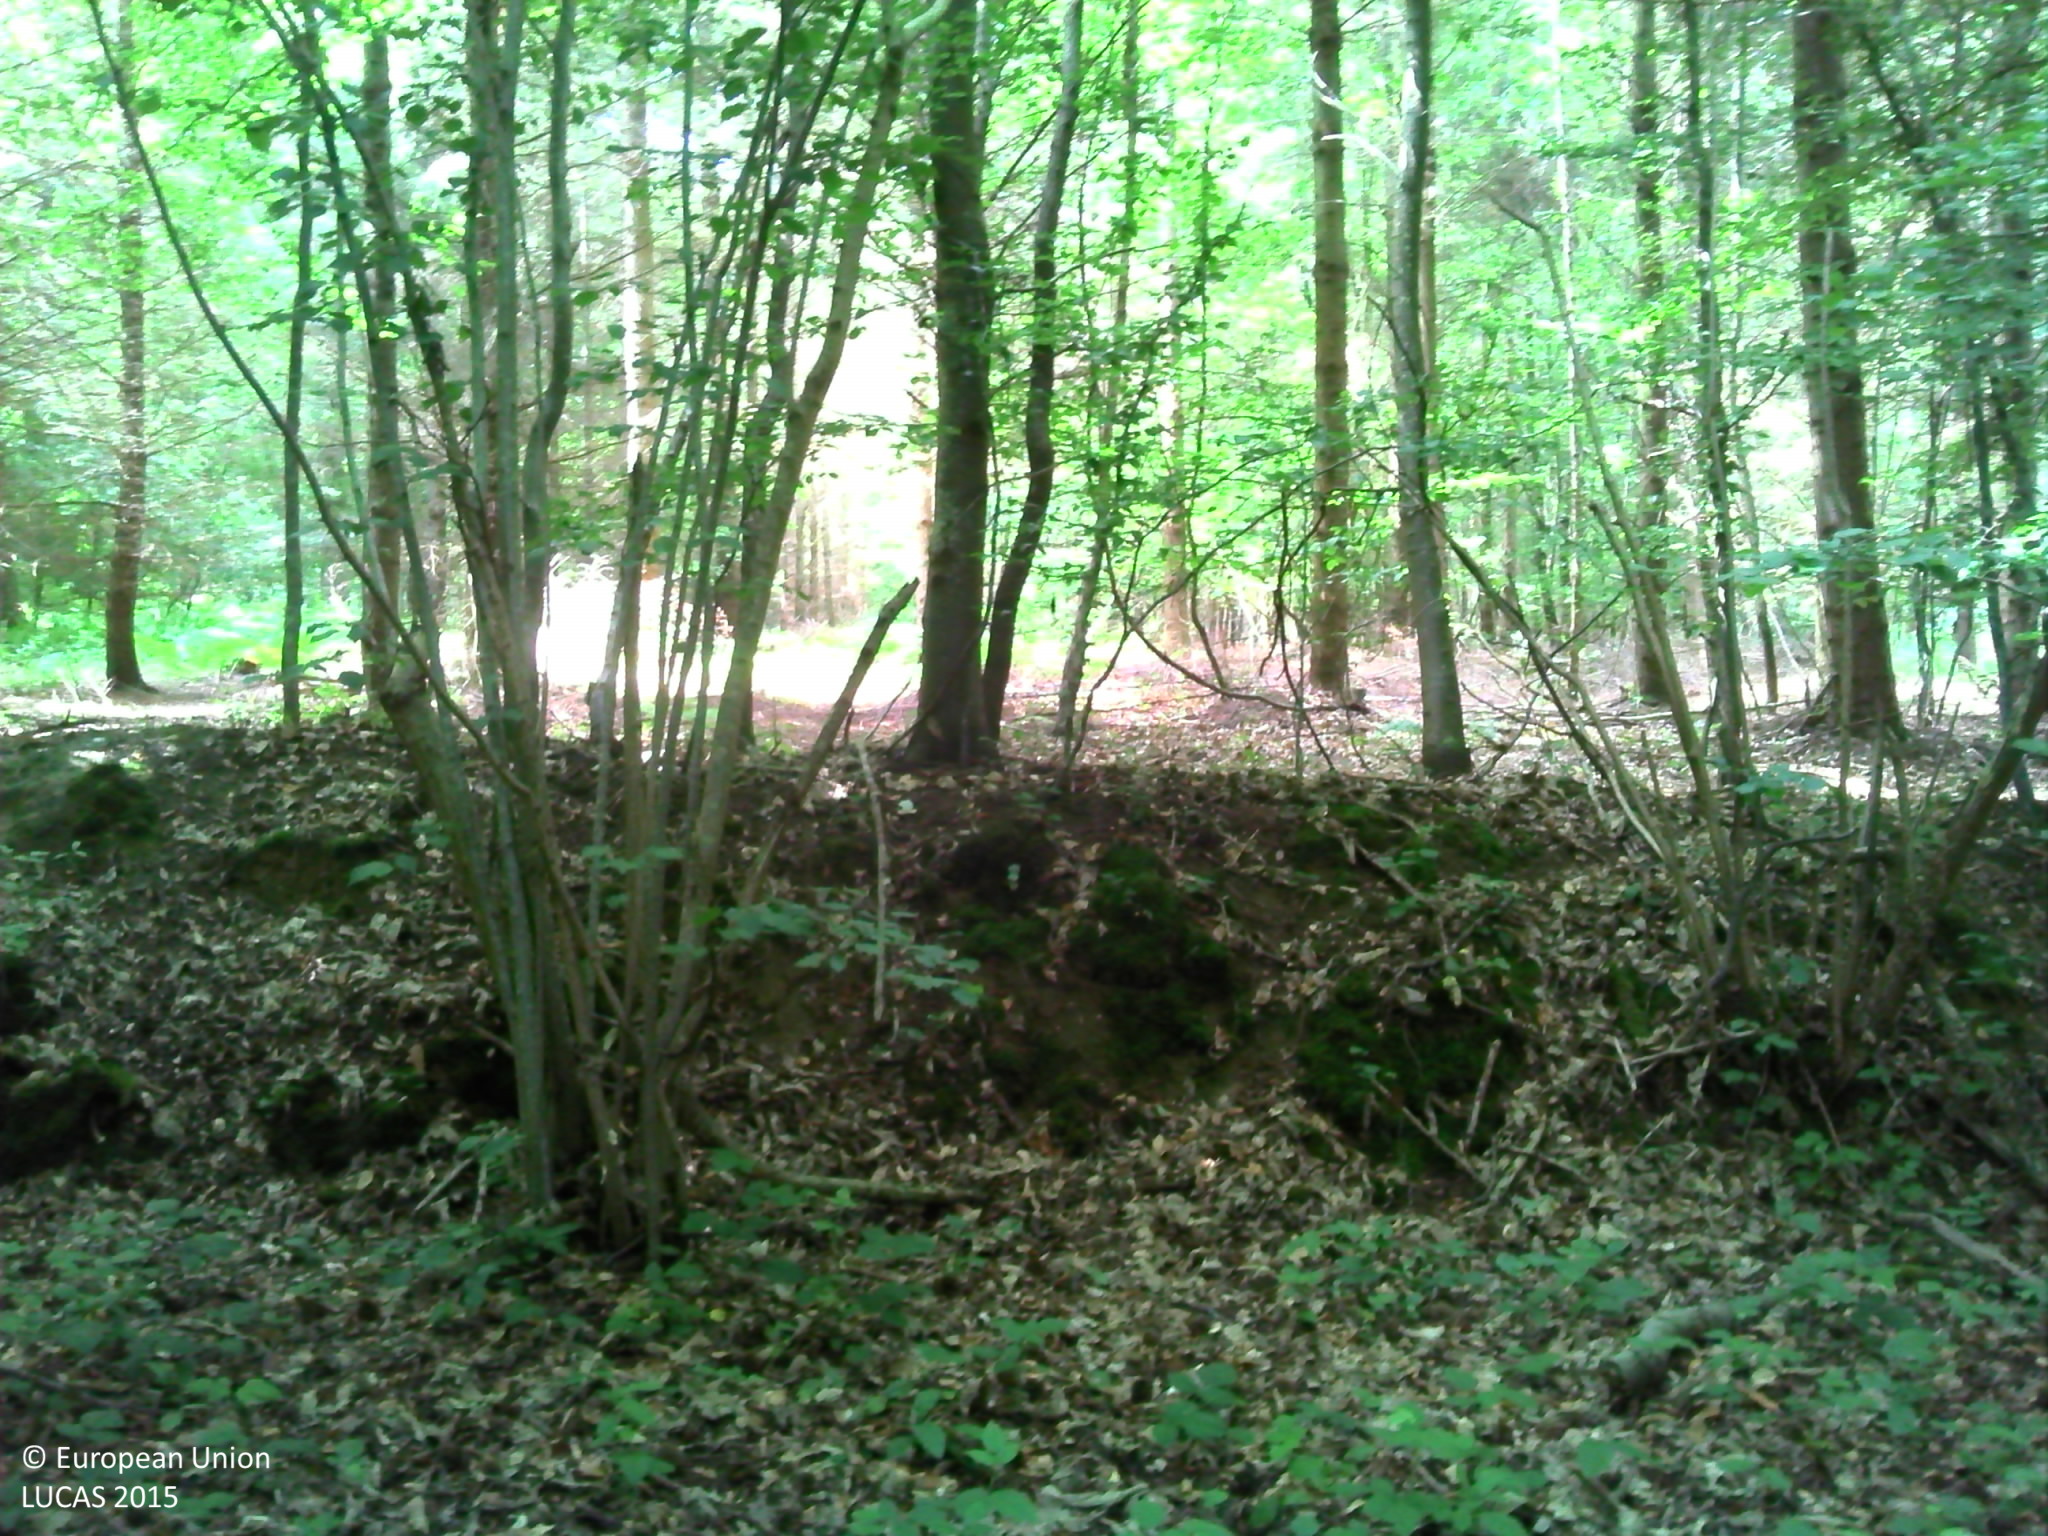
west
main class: Woodland
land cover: Broadleaved woodland
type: mesophytic deciduous forest
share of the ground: > 75 %
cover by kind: broadleaved forest trees 80 %, herbaceous plants 10 %, consolidated bare surface 10 %
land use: Forestry
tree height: > 5 m
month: June
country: FR
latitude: 49.2536
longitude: 1.0619
